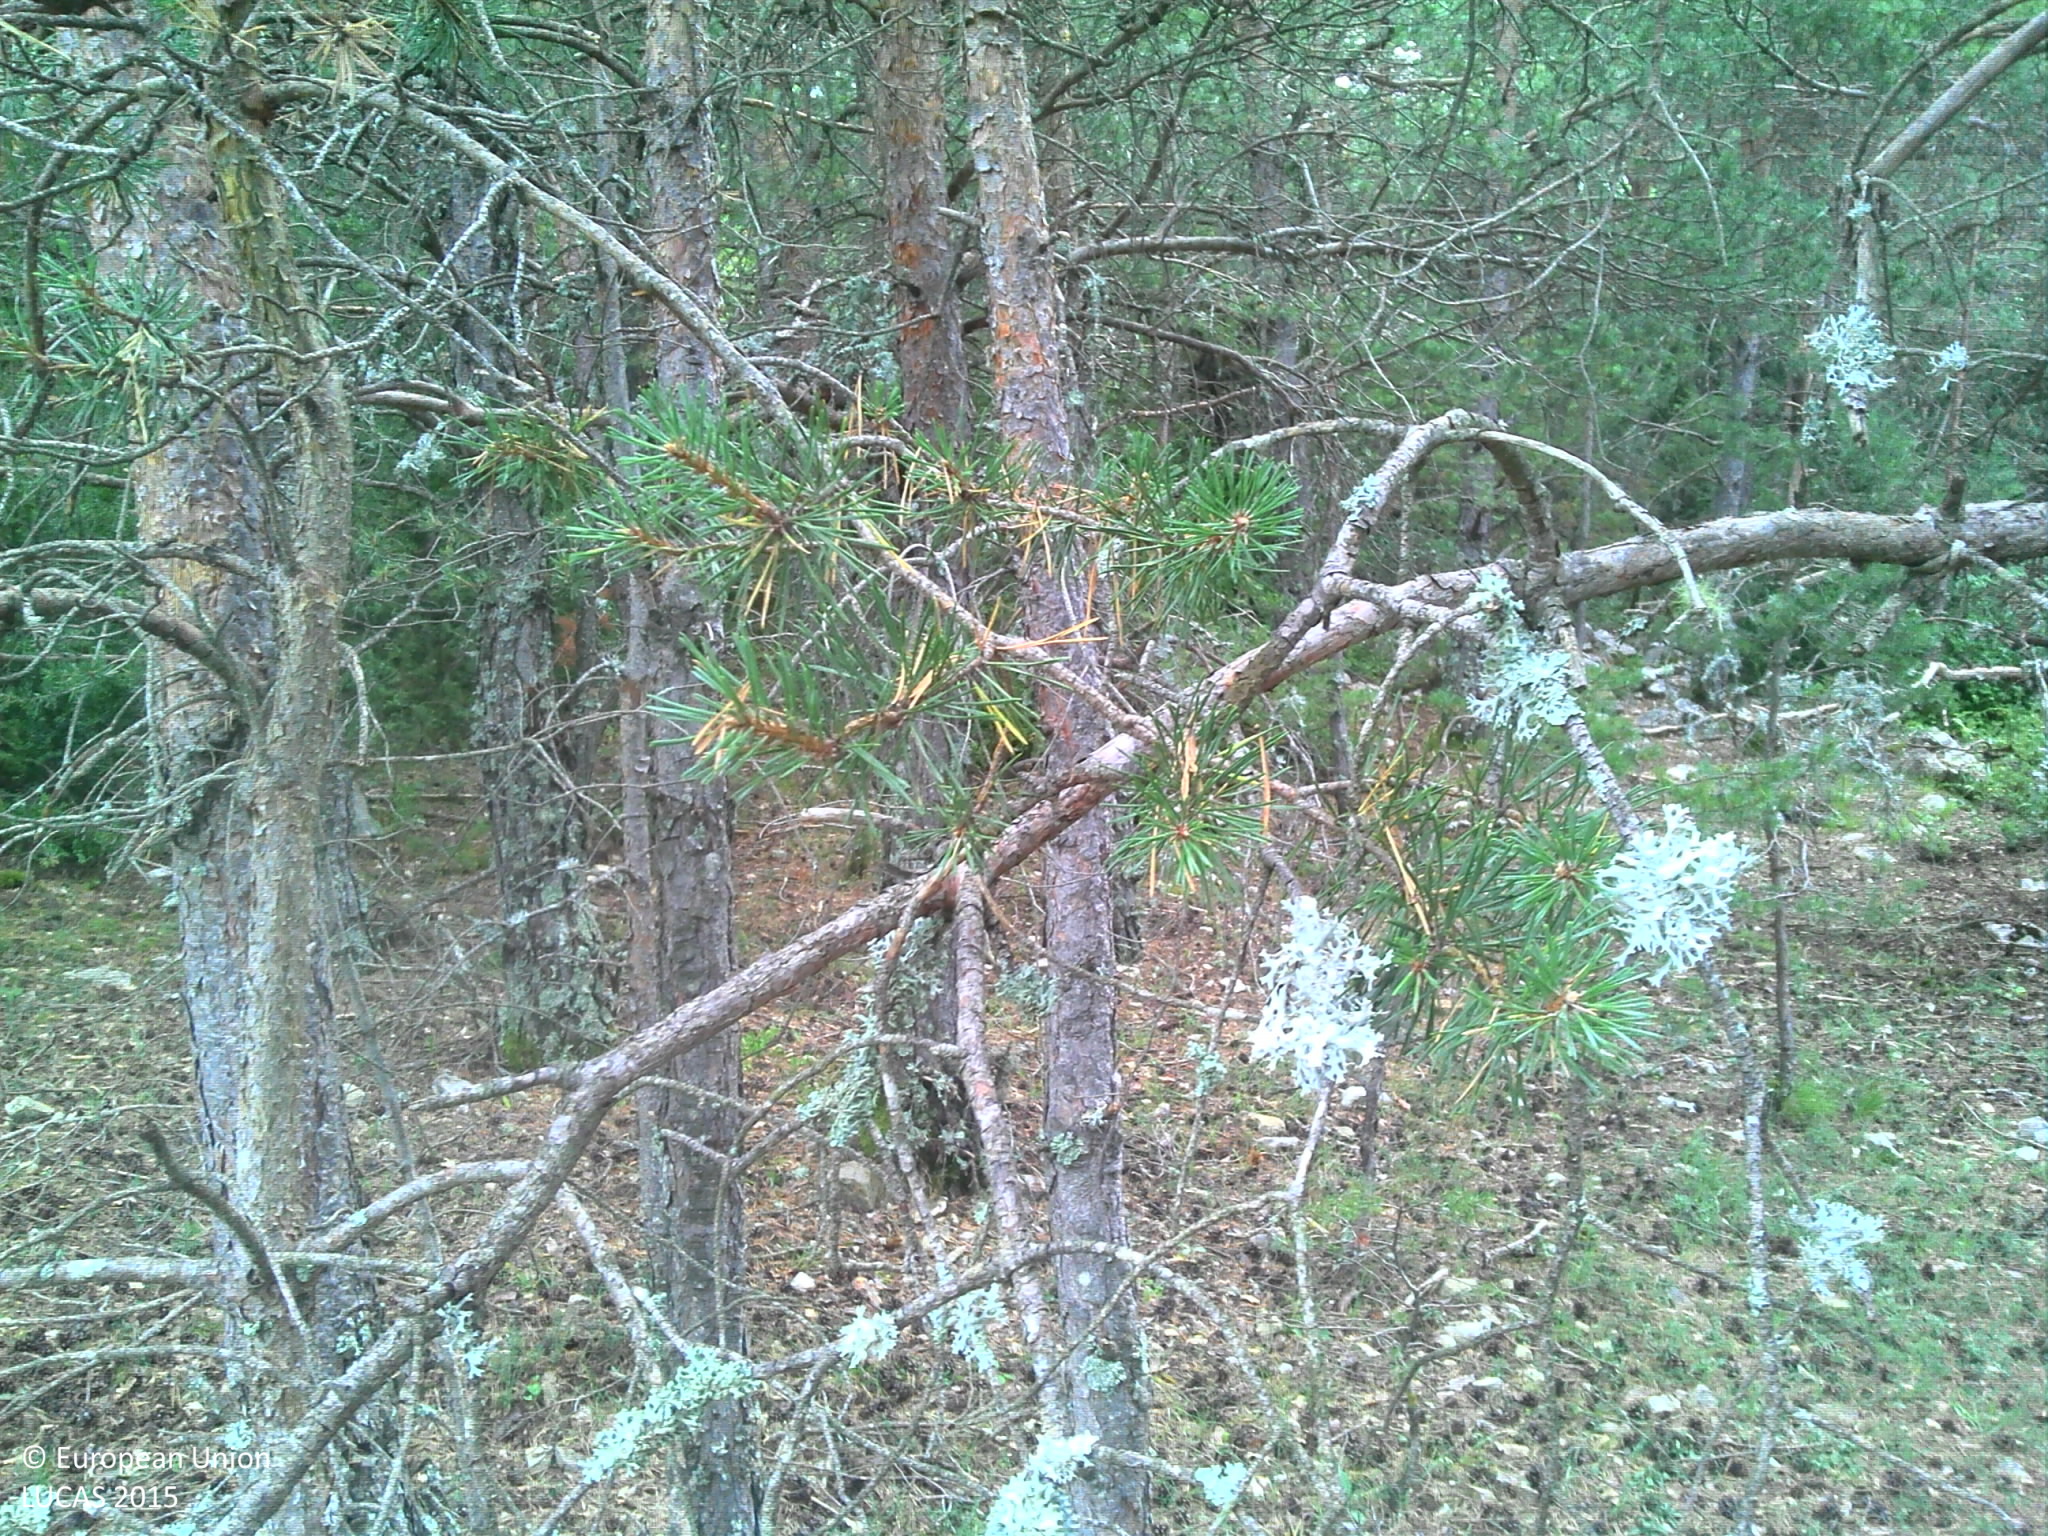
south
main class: Woodland
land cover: Pine dominated coniferous woodland
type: alpine coniferous forest
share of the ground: 50 - 75 %
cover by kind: coniferous forest trees 90 %, consolidated bare surface 10 %
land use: Semi-natural and natural areas not in use
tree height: > 5 m
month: August
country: FR
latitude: 44.0679
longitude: 6.2994
